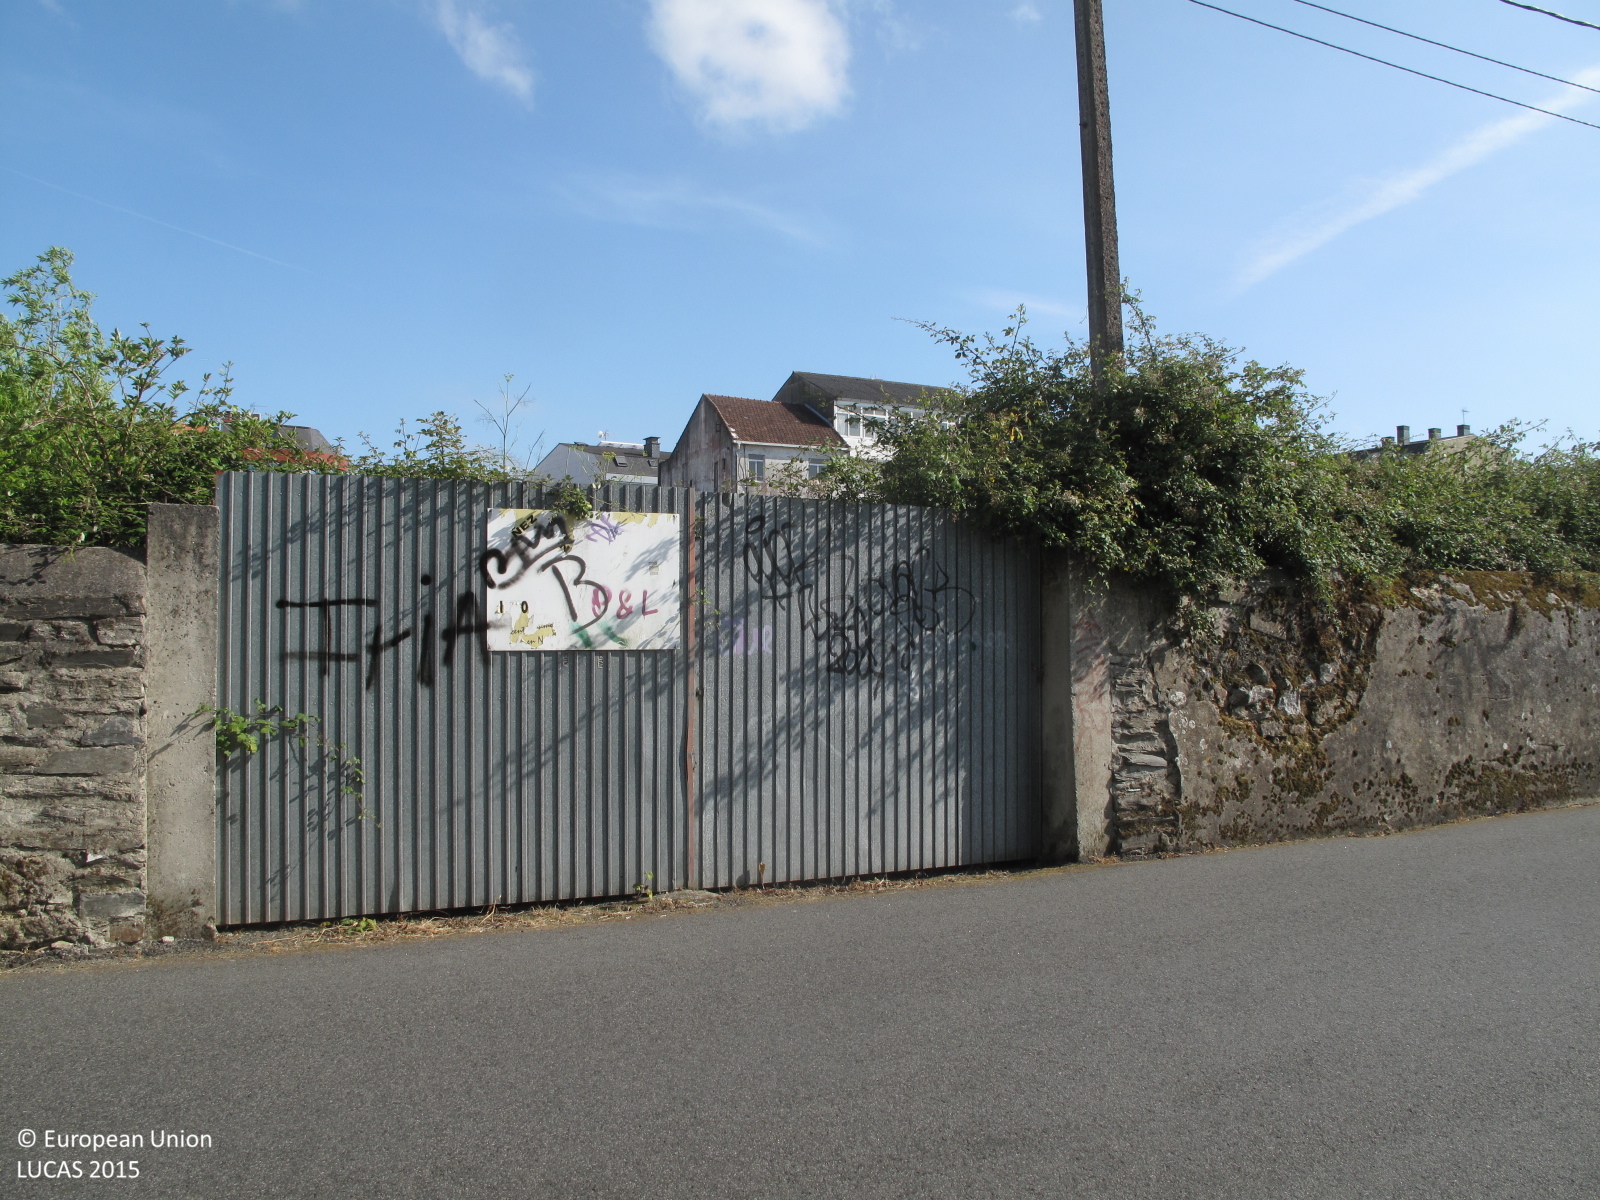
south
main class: Cropland
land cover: Apple fruit
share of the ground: 25 - 50 %
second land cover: Grassland without tree/shrub cover
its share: > 75 %
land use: Kitchen garden
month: July
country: ES
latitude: 43.5002
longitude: -8.1957
